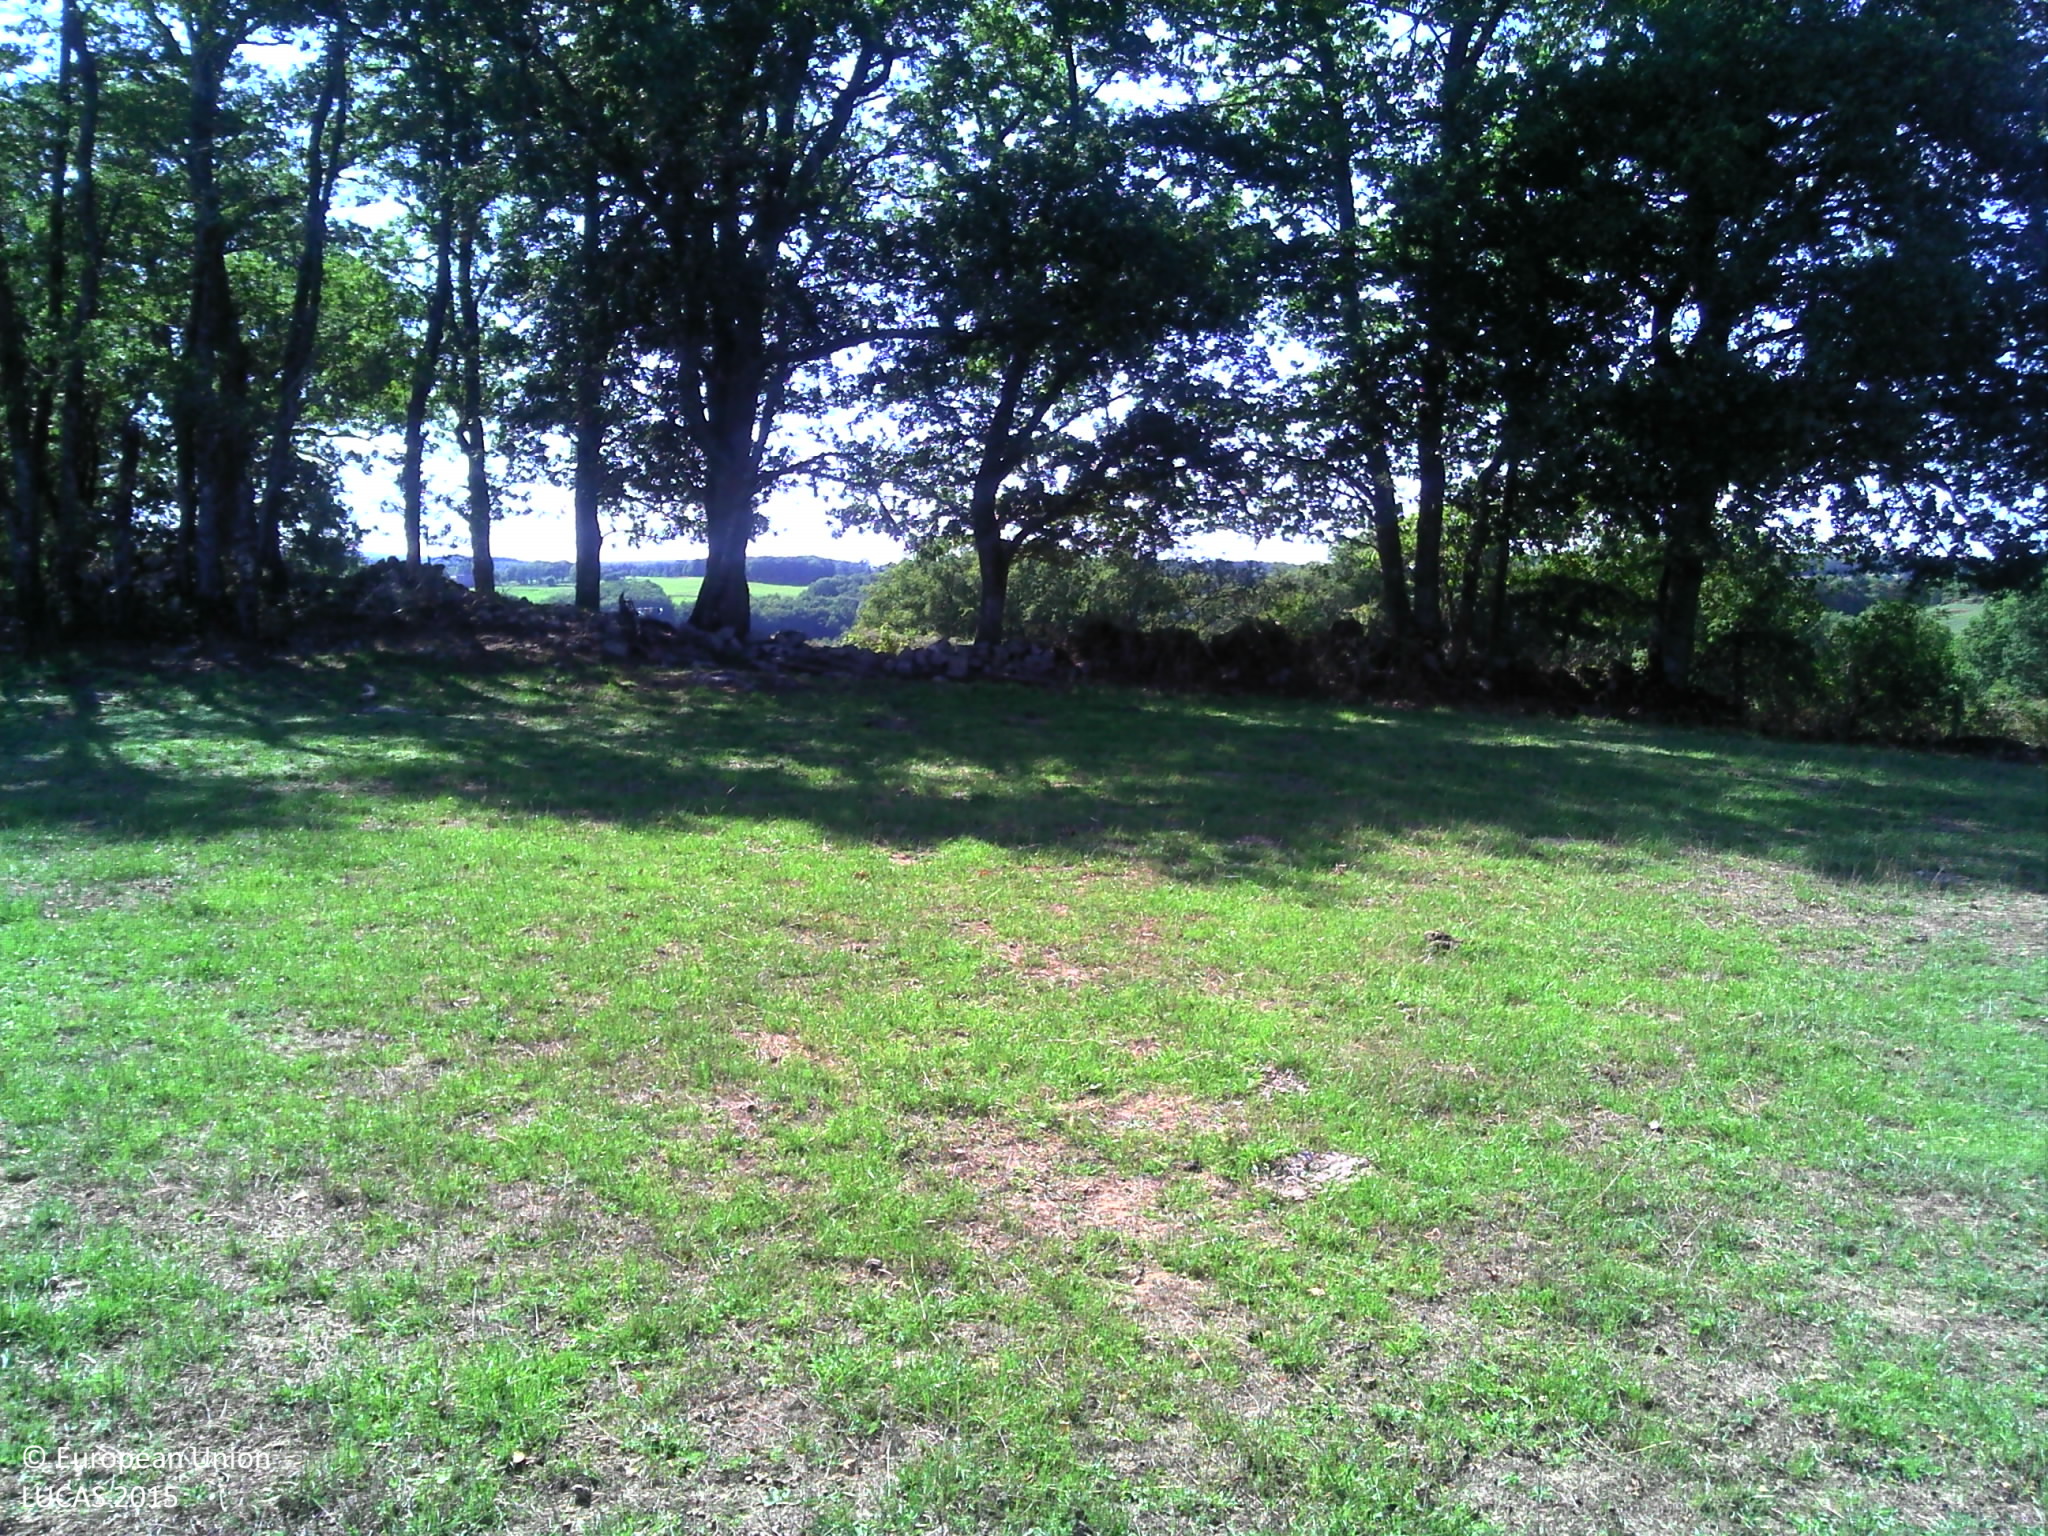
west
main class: Grassland
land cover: Grassland without tree/shrub cover
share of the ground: > 75 %
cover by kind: herbaceous plants 100 %
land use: Agriculture (excluding fallow land and kitchen gardens)
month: August
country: FR
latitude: 45.9106
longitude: 2.2998
